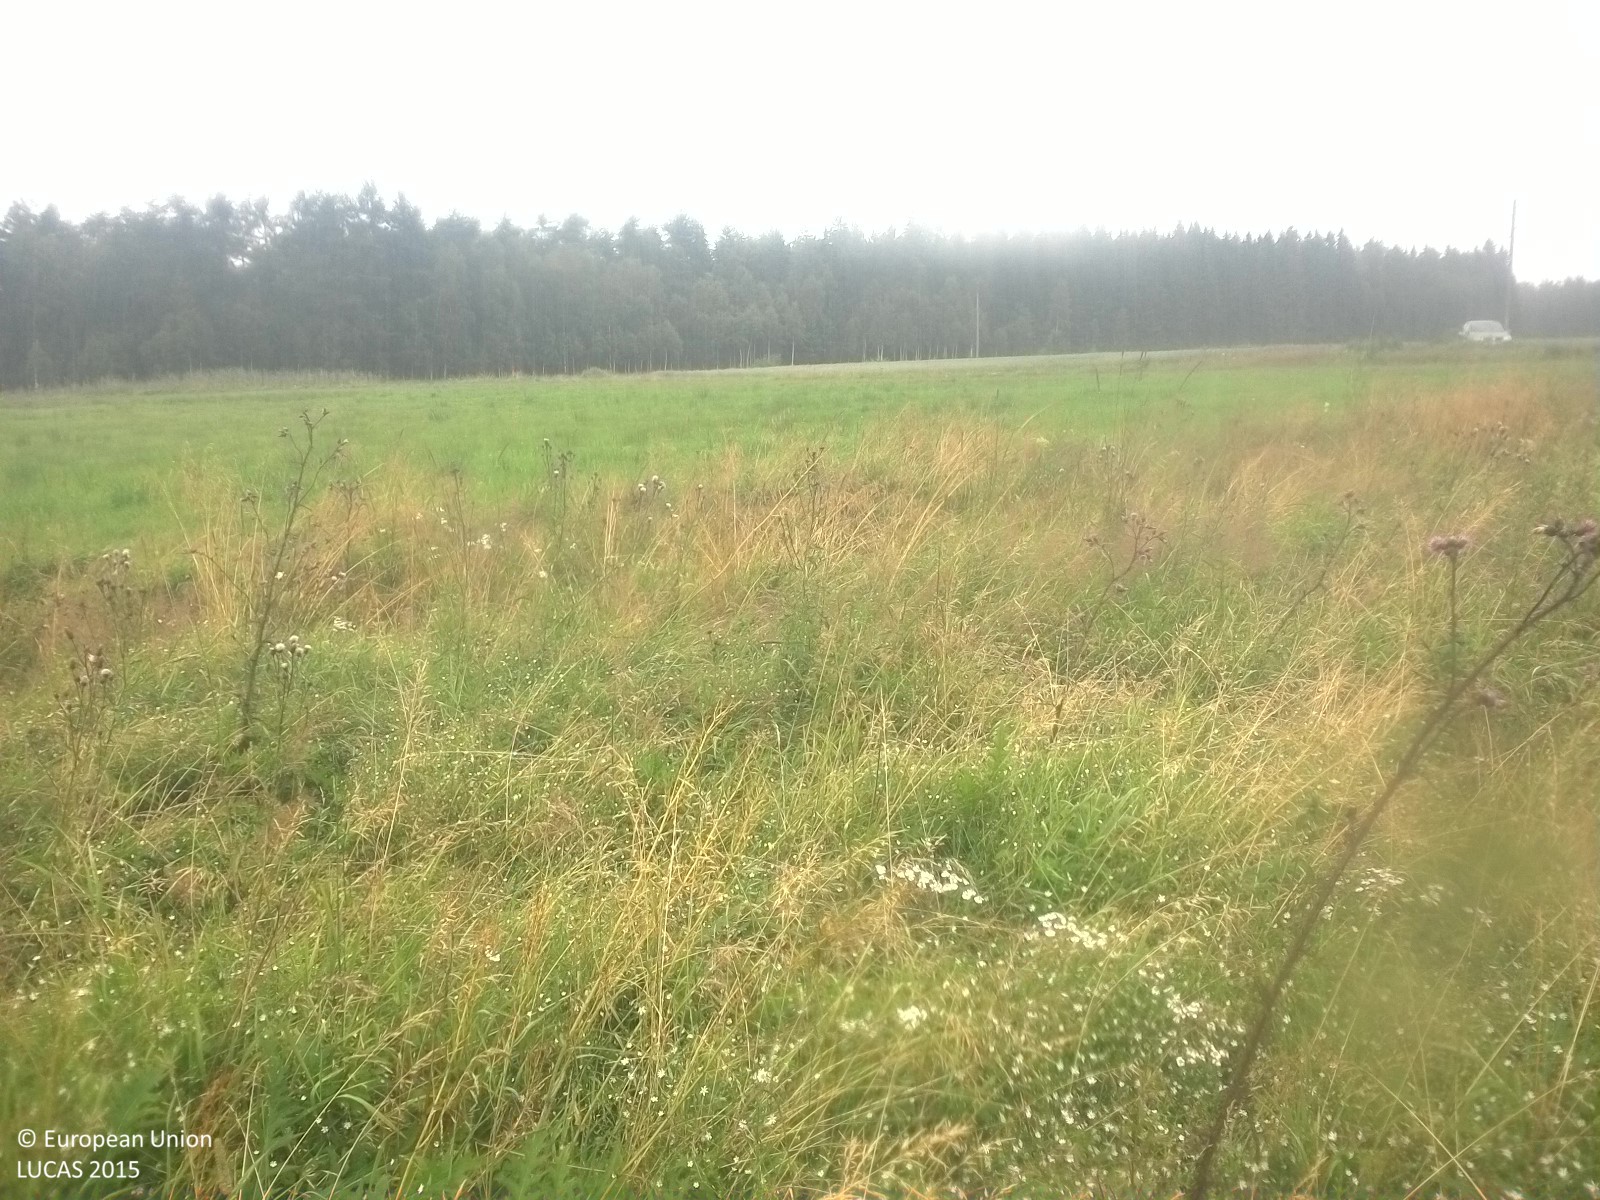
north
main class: Grassland
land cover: Spontaneously vegetated surfaces
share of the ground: > 75 %
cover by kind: herbaceous plants 100 %
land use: Agriculture (excluding fallow land and kitchen gardens)
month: July
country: SE
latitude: 58.9001
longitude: 15.0436
